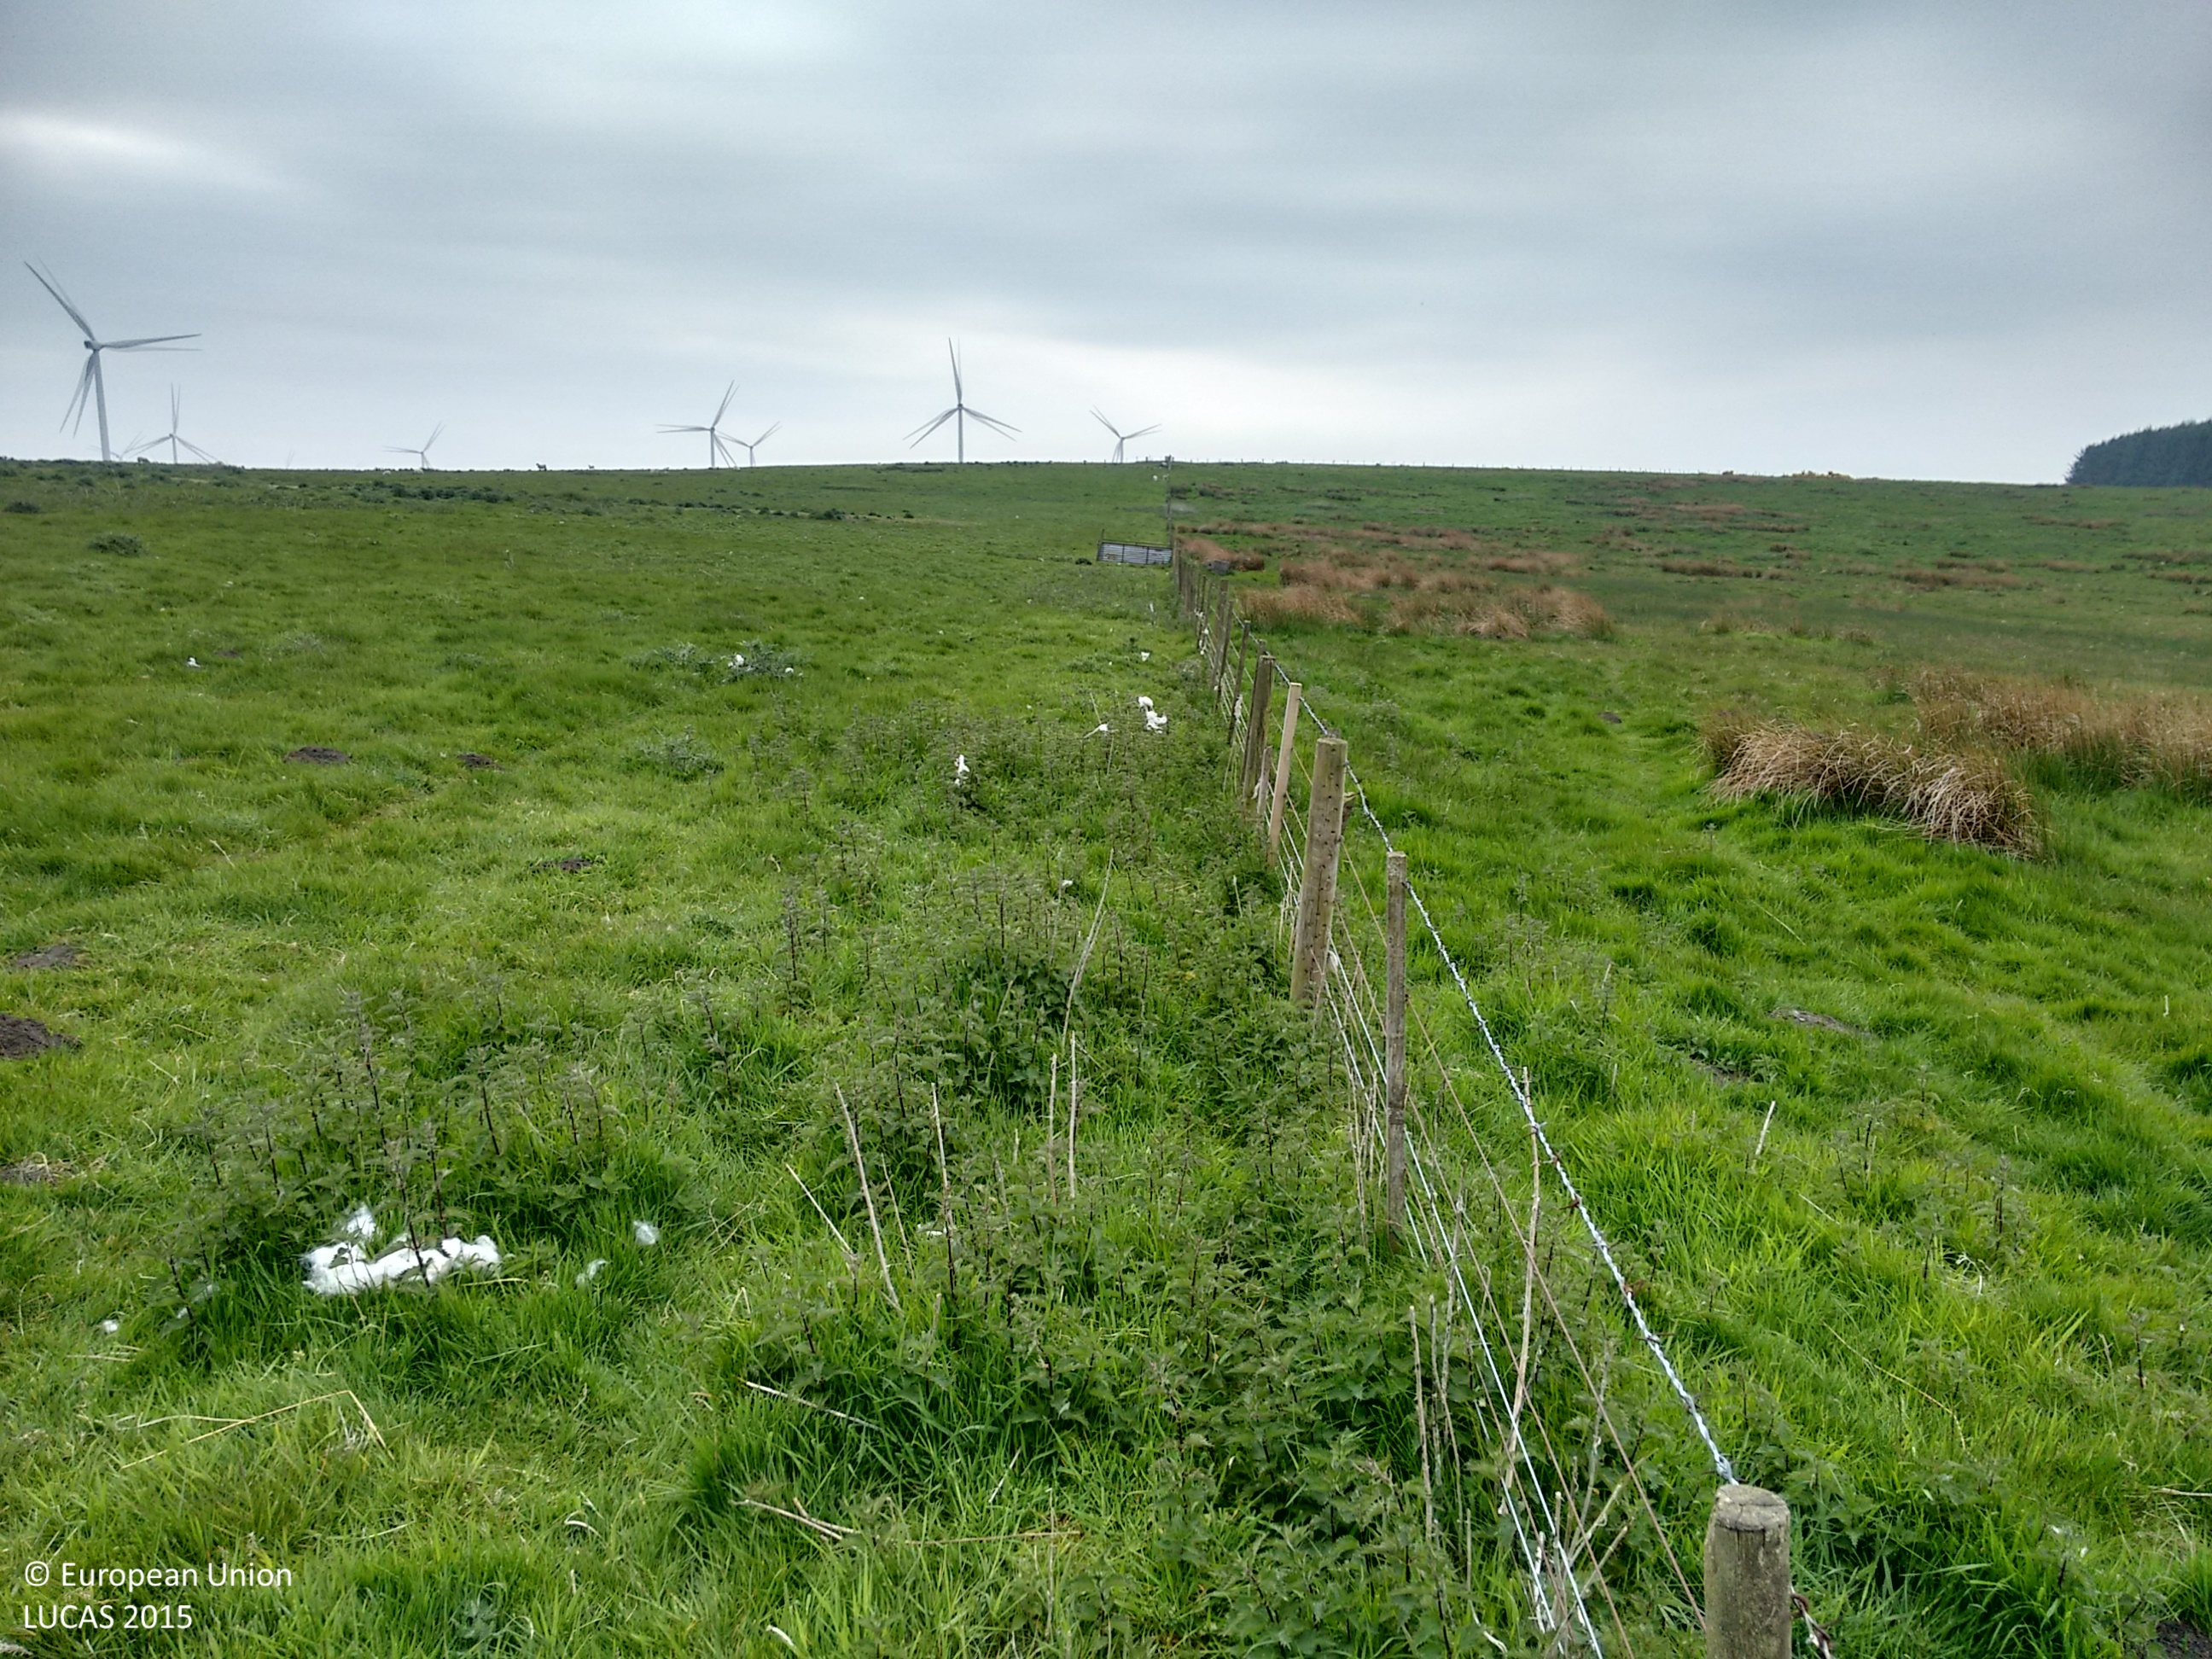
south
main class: Grassland
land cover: Grassland without tree/shrub cover
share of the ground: > 75 %
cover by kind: herbaceous plants 100 %
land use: Agriculture (excluding fallow land and kitchen gardens)
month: June
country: GB
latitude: 55.5152
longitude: -1.7849
